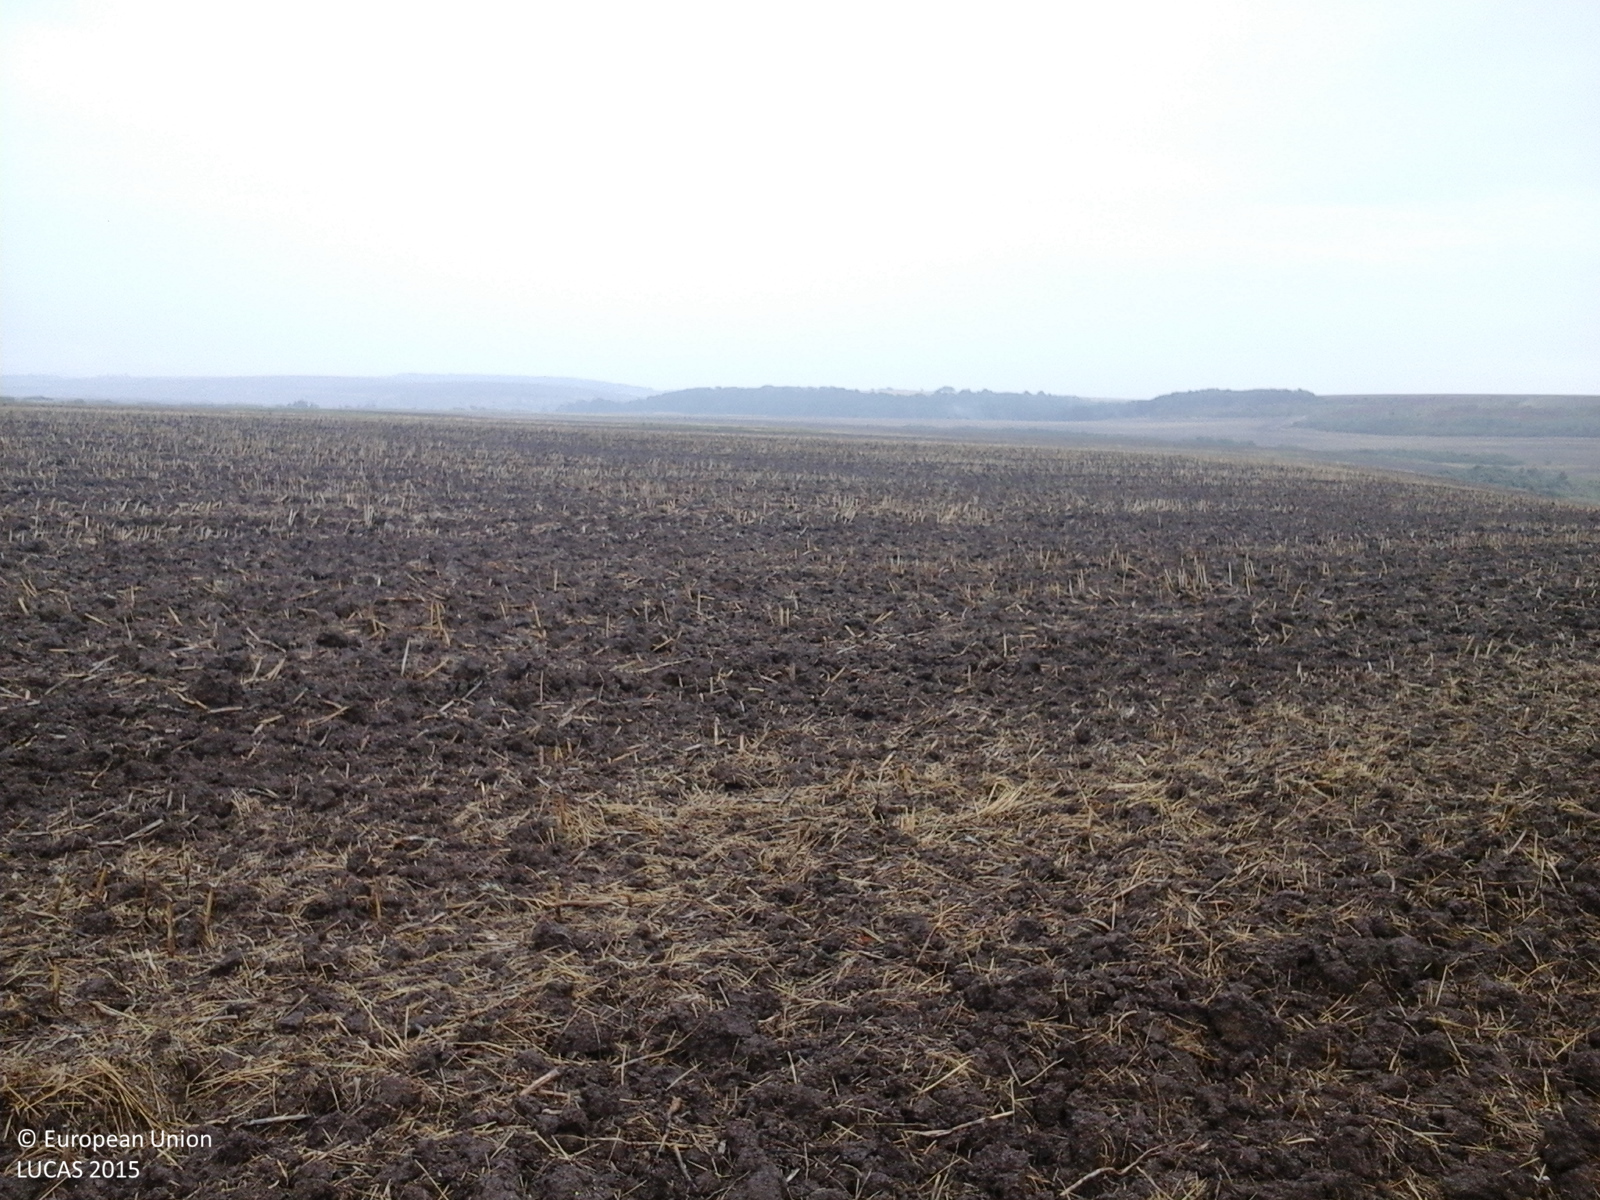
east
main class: Grassland
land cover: Spontaneously vegetated surfaces
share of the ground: > 75 %
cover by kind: herbaceous plants 100 %
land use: Fallow land
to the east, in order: Spontaneously vegetated surfaces; Tracks; Fences; Abandoned hedges; Rape and turnip rape
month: August
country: RO
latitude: 45.9372
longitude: 21.4226
